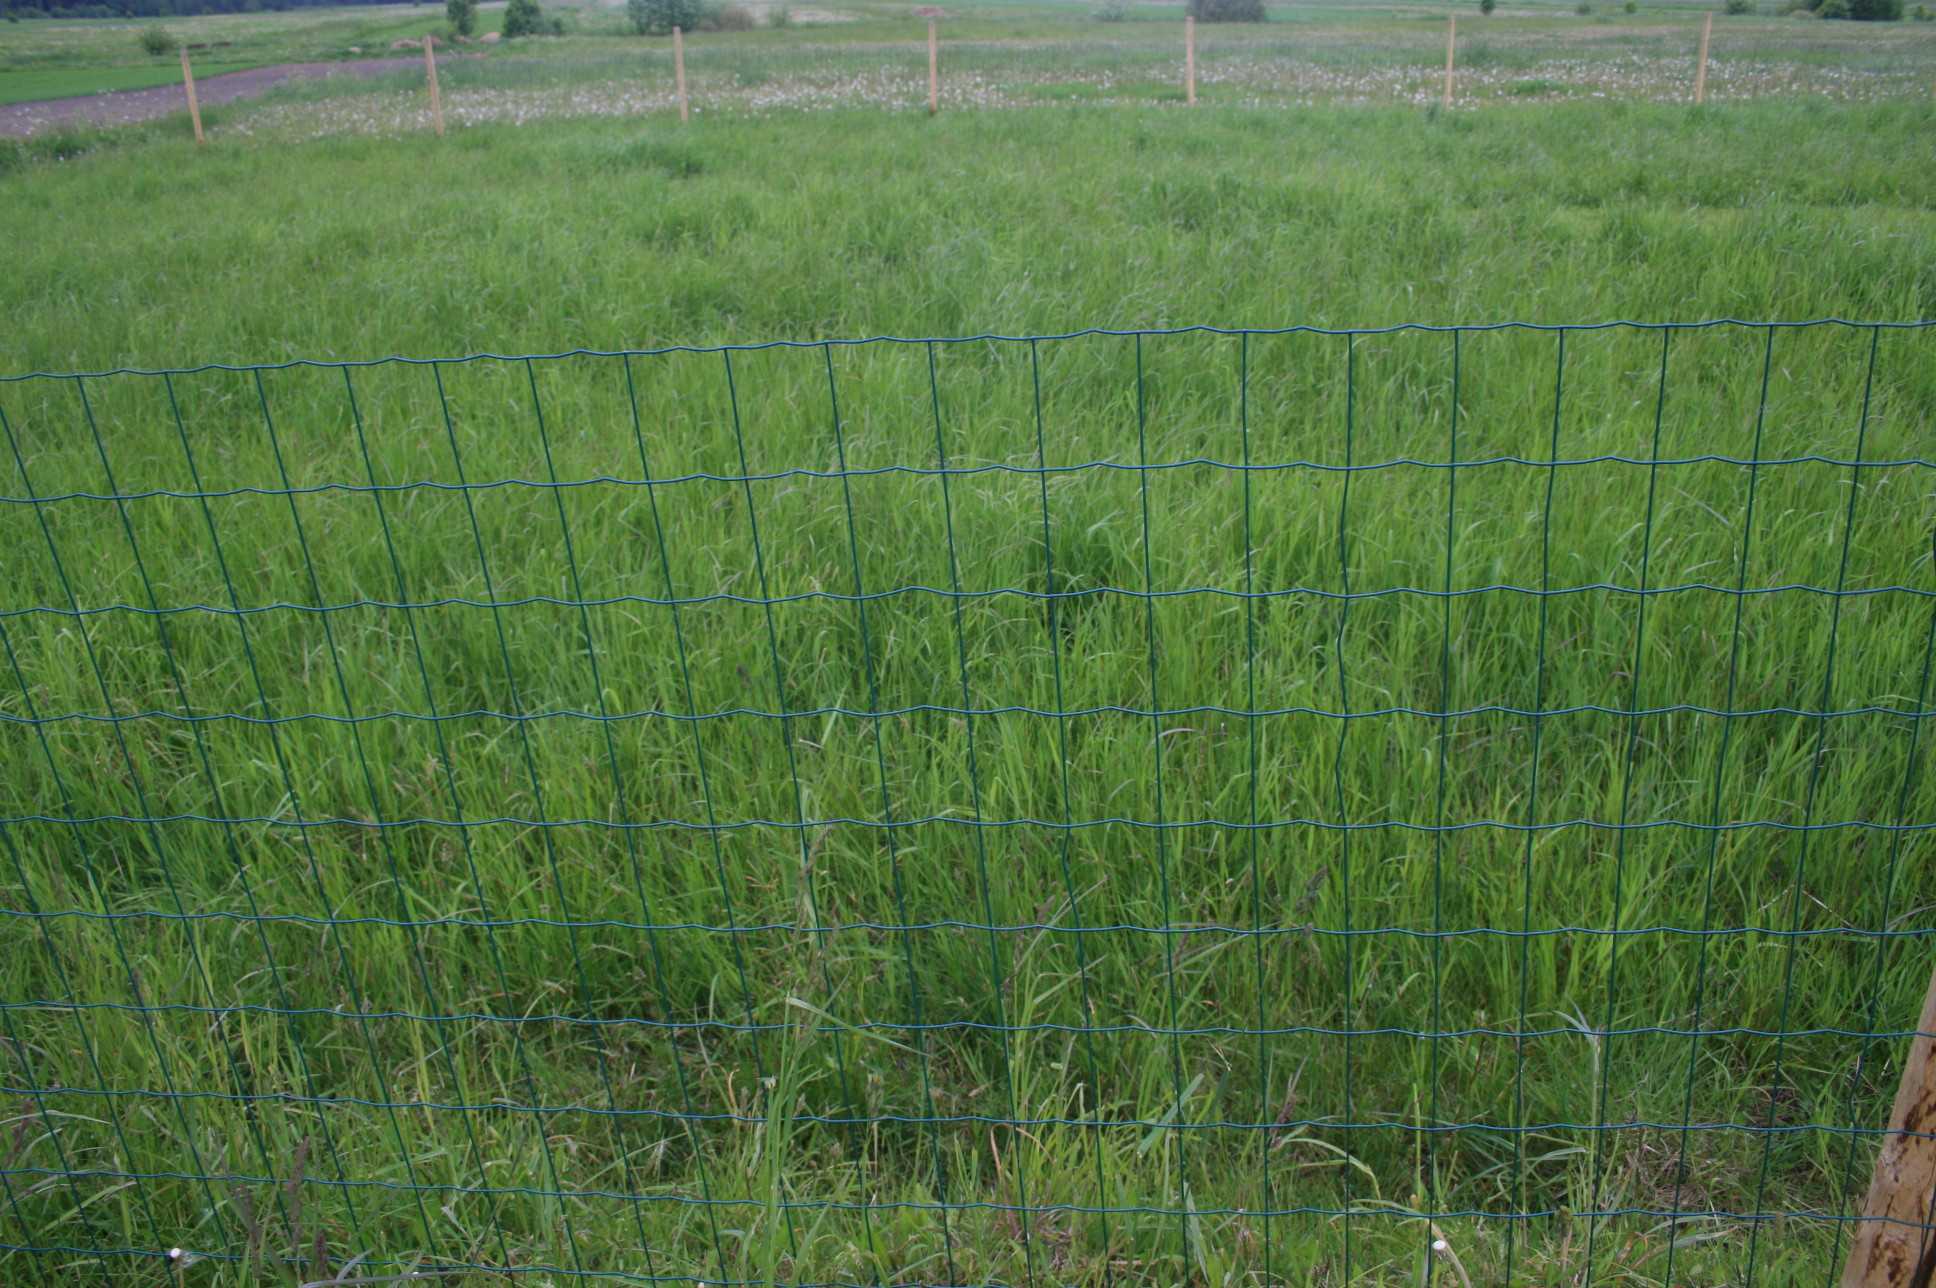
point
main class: Grassland
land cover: Grassland without tree/shrub cover
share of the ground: > 75 %
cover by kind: herbaceous plants 100 %
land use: Agriculture (excluding fallow land and kitchen gardens)
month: May
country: LT
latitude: 55.8010
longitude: 21.6445
